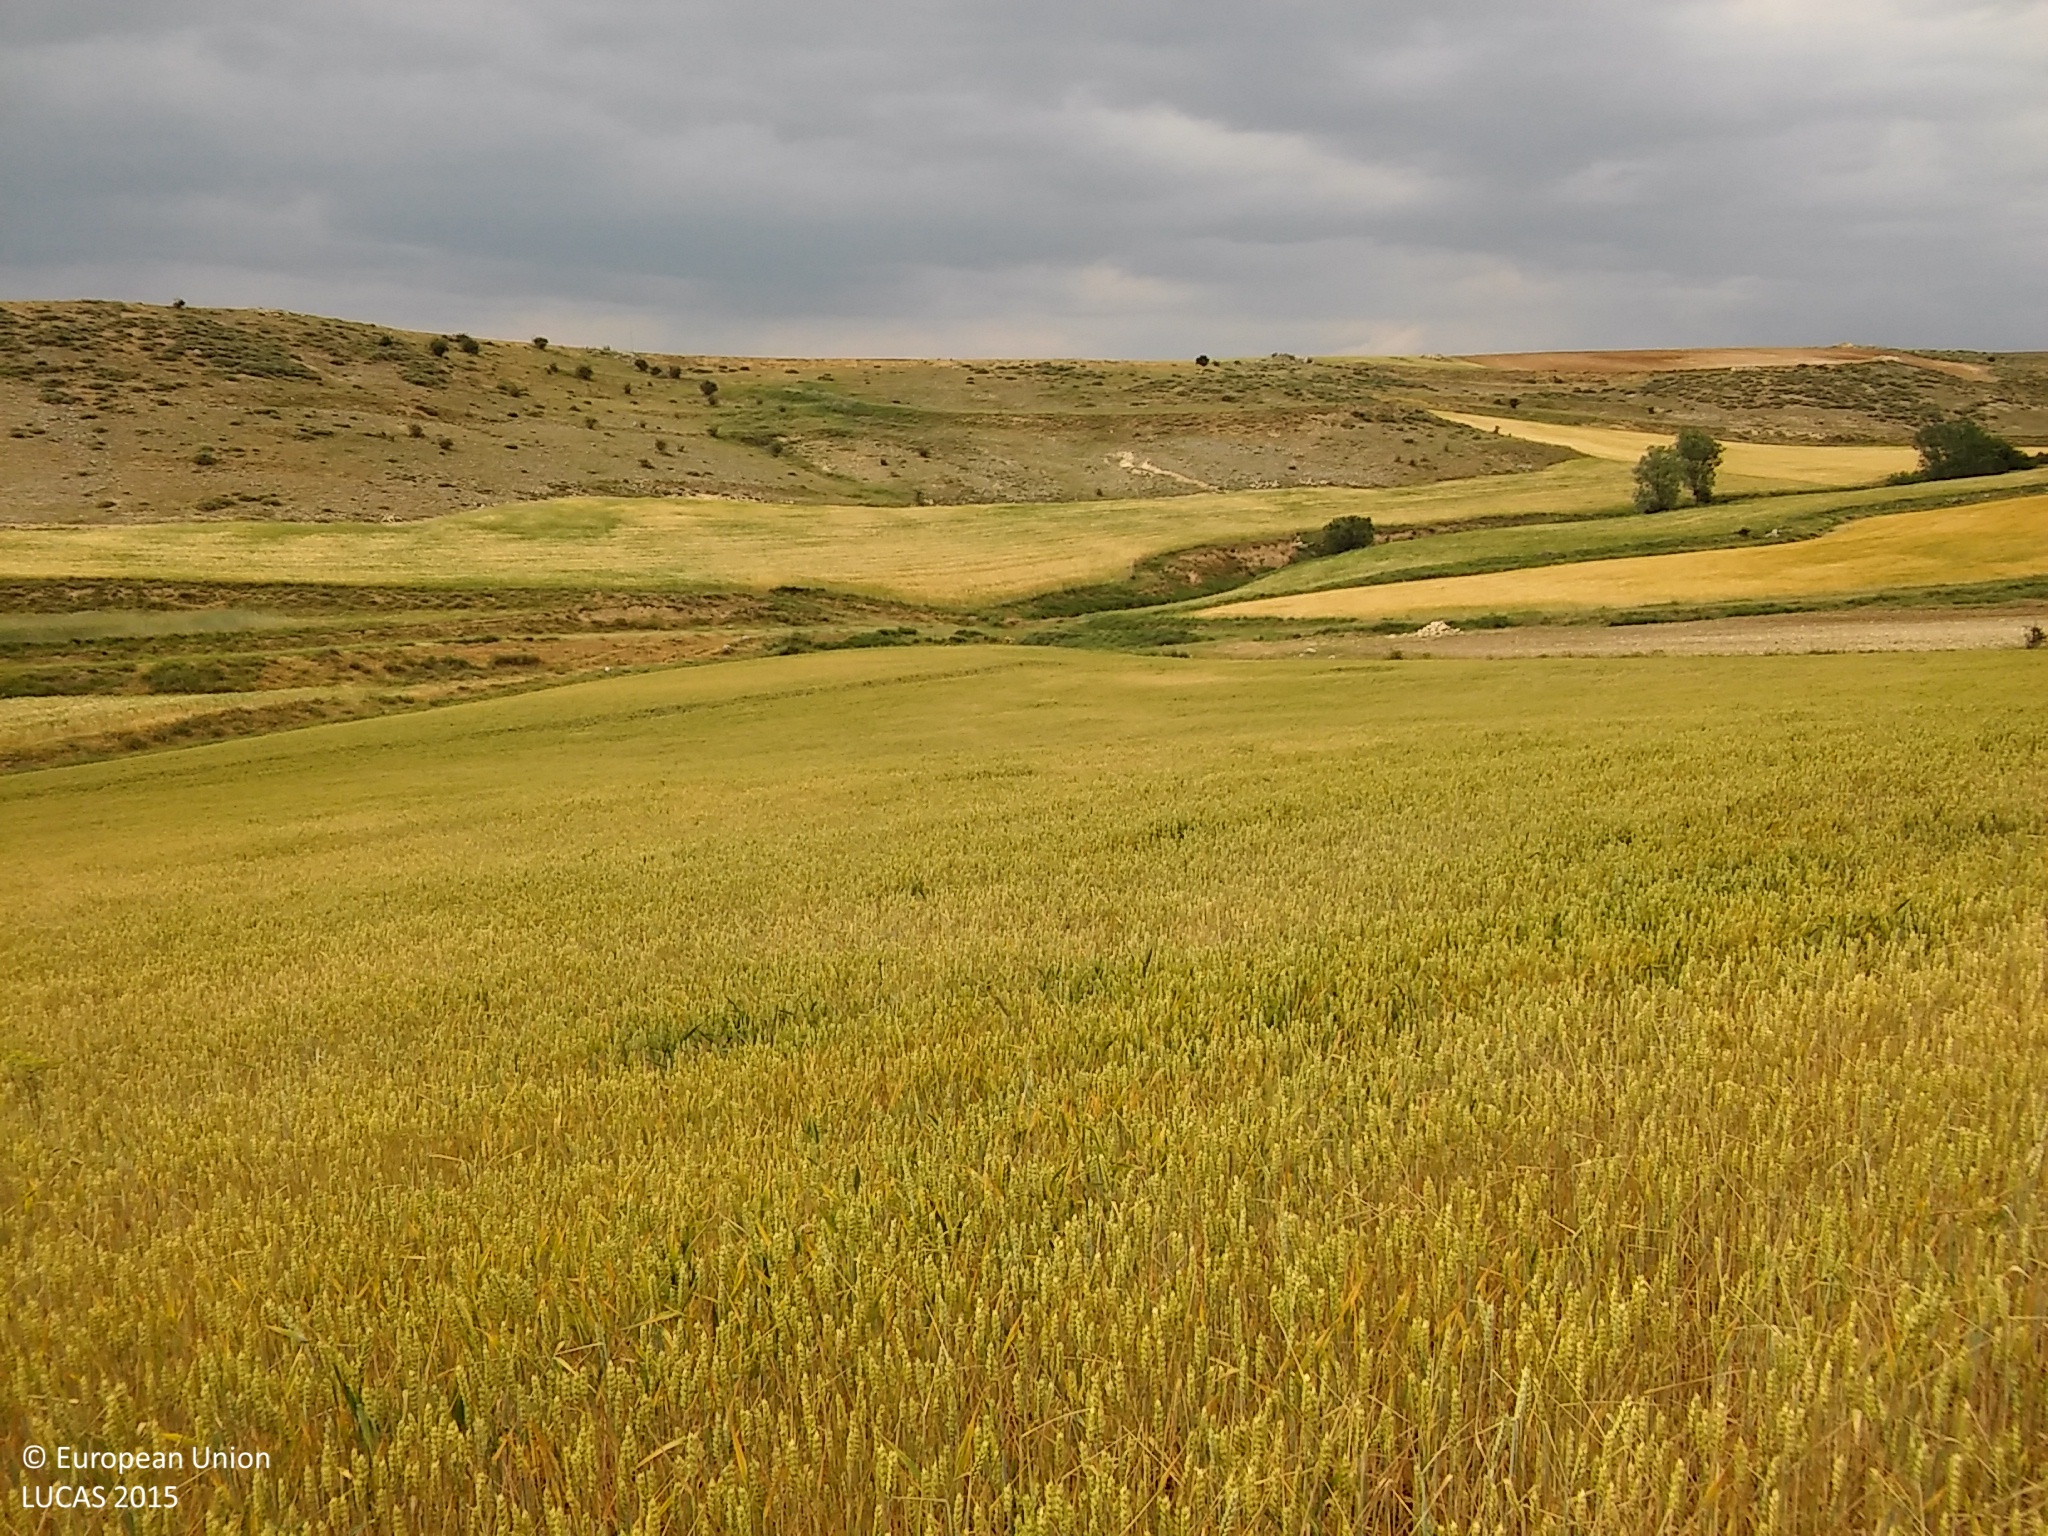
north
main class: Cropland
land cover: Common wheat
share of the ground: > 75 %
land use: Agriculture (excluding fallow land and kitchen gardens)
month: June
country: ES
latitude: 41.2023
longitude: -3.7257
